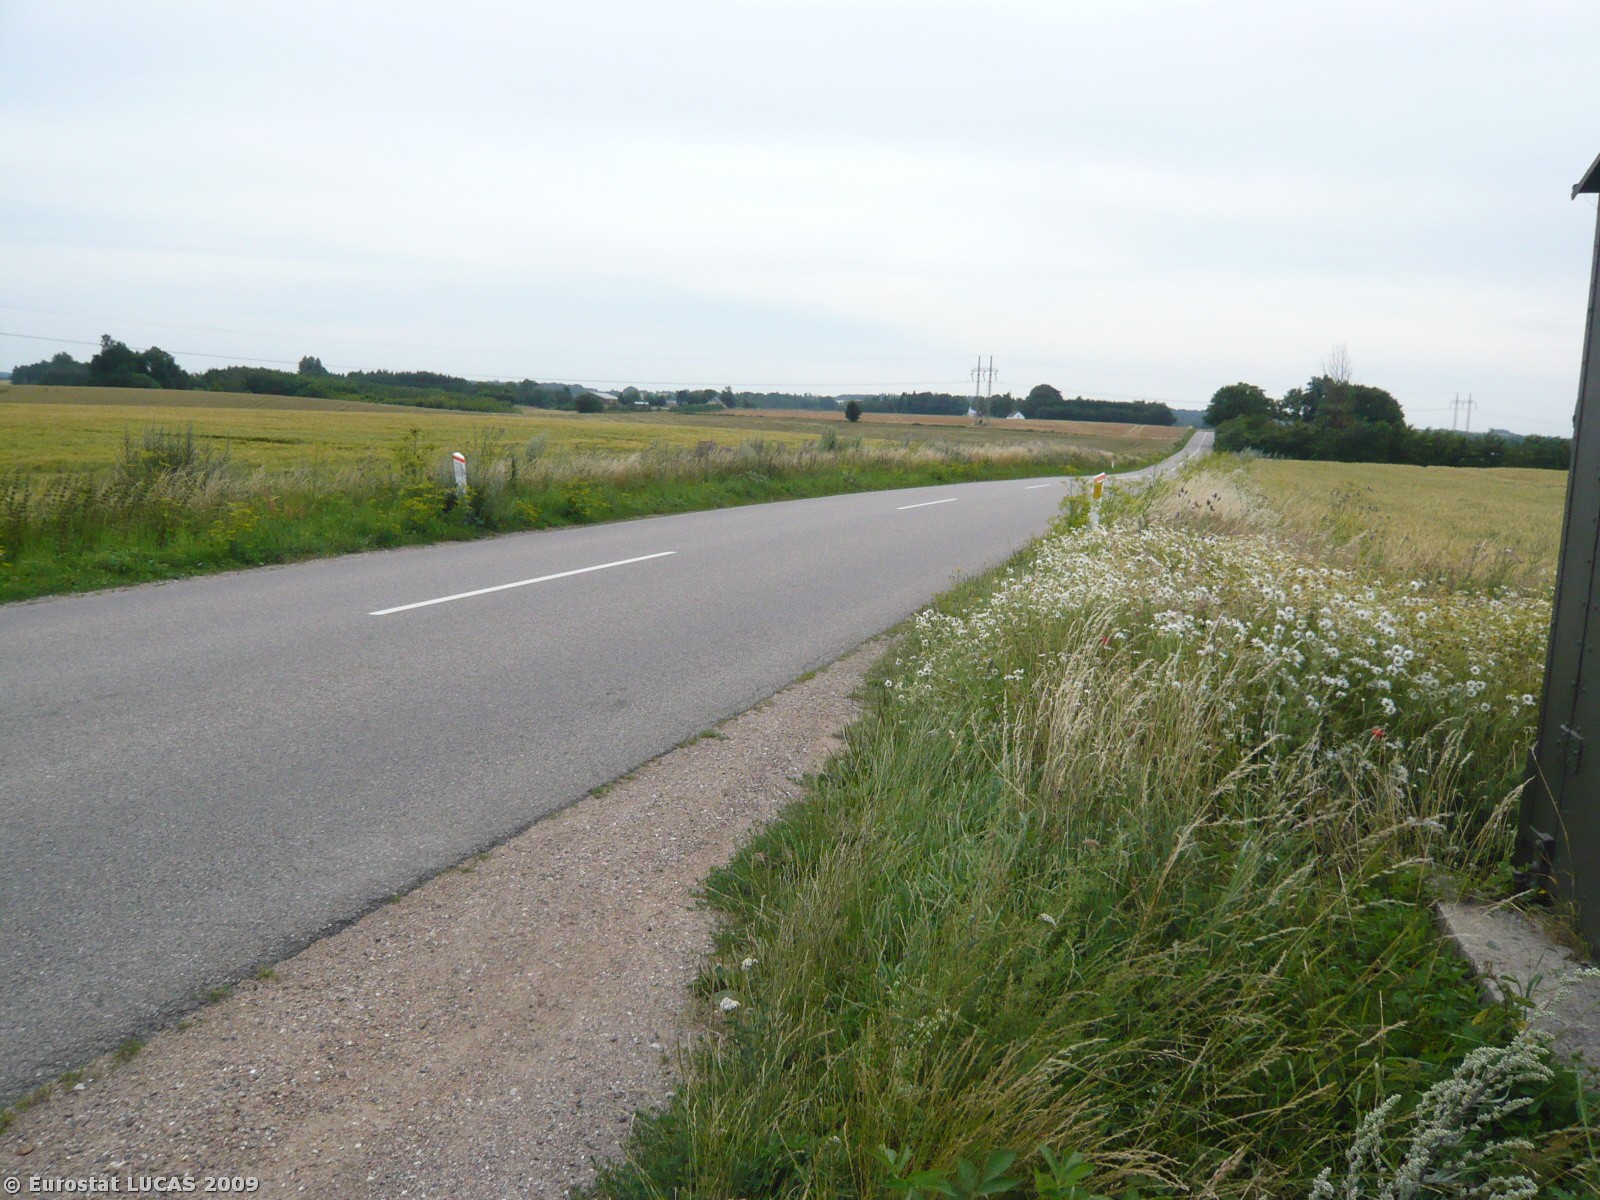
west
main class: Cropland
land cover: Common wheat
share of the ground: > 75 %
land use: Agriculture (excluding fallow land and kitchen gardens)
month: July
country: DK
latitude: 55.5648
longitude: 11.7269
